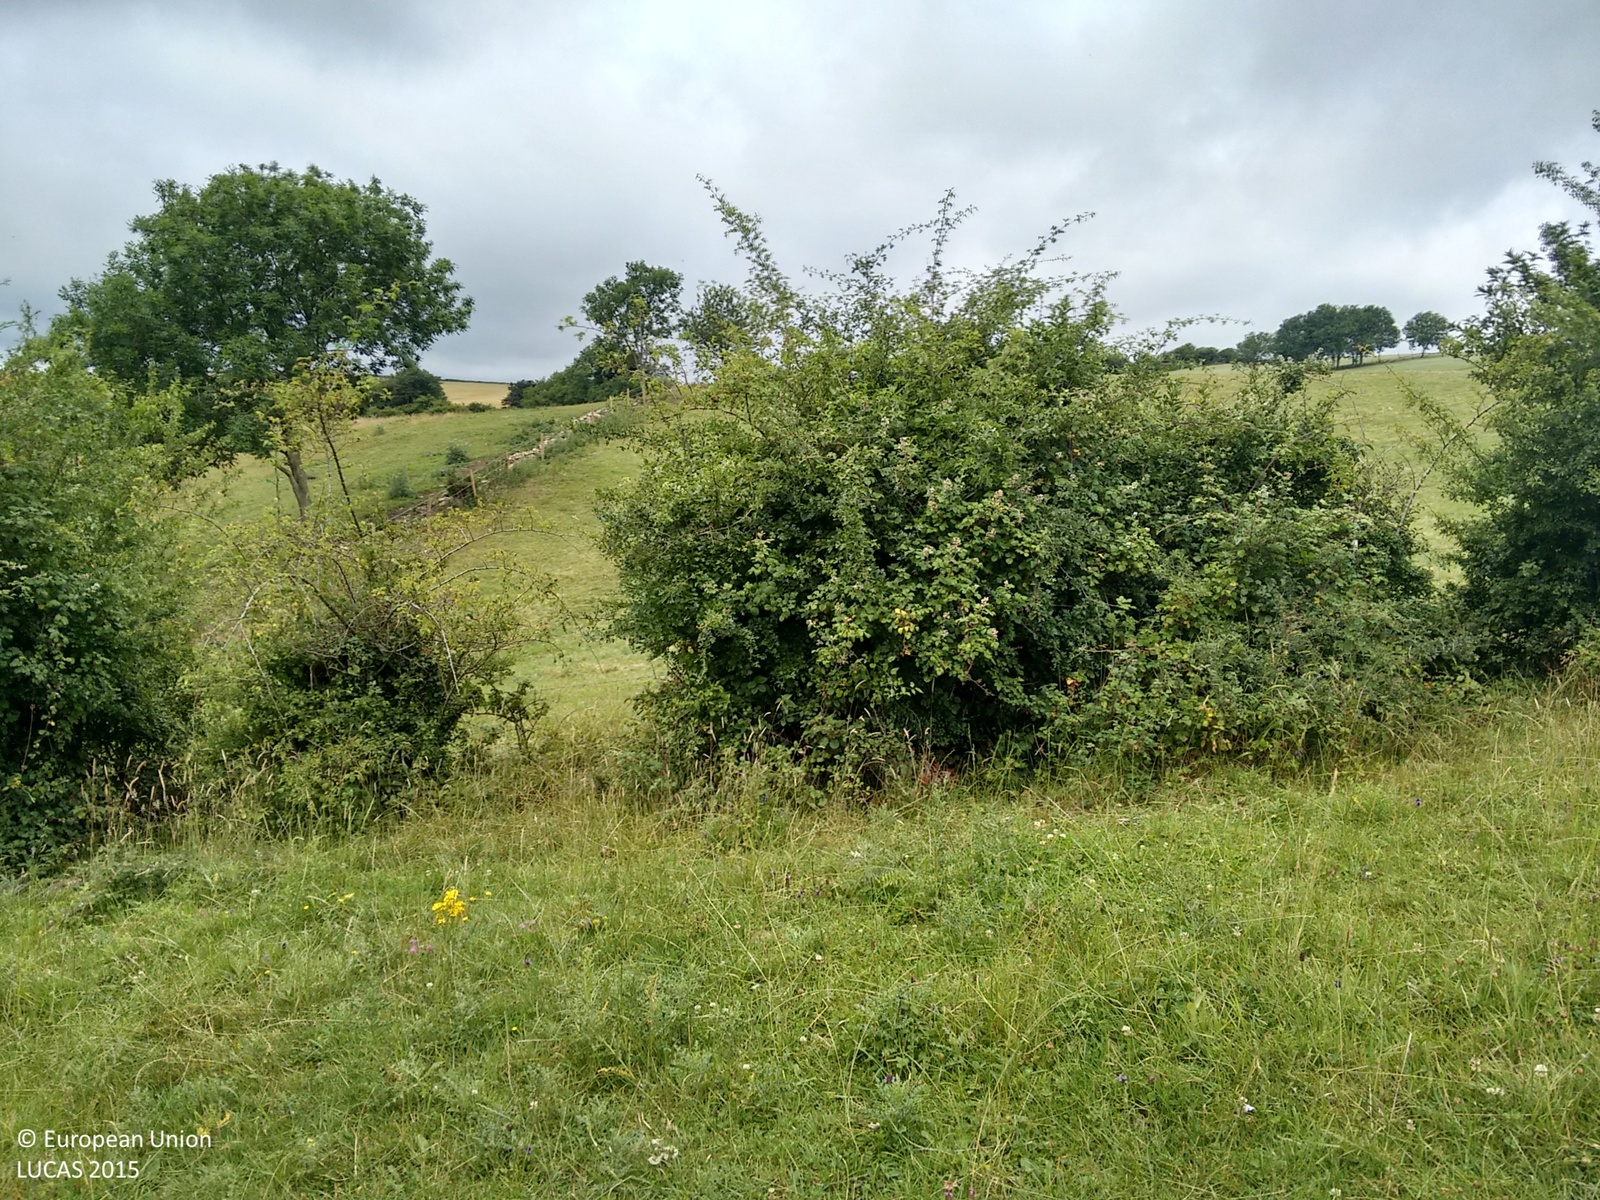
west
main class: Grassland
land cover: Grassland without tree/shrub cover
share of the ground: > 75 %
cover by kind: herbaceous plants 100 %
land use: Agriculture (excluding fallow land and kitchen gardens)
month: July
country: GB
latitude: 51.4576
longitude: -2.3403
